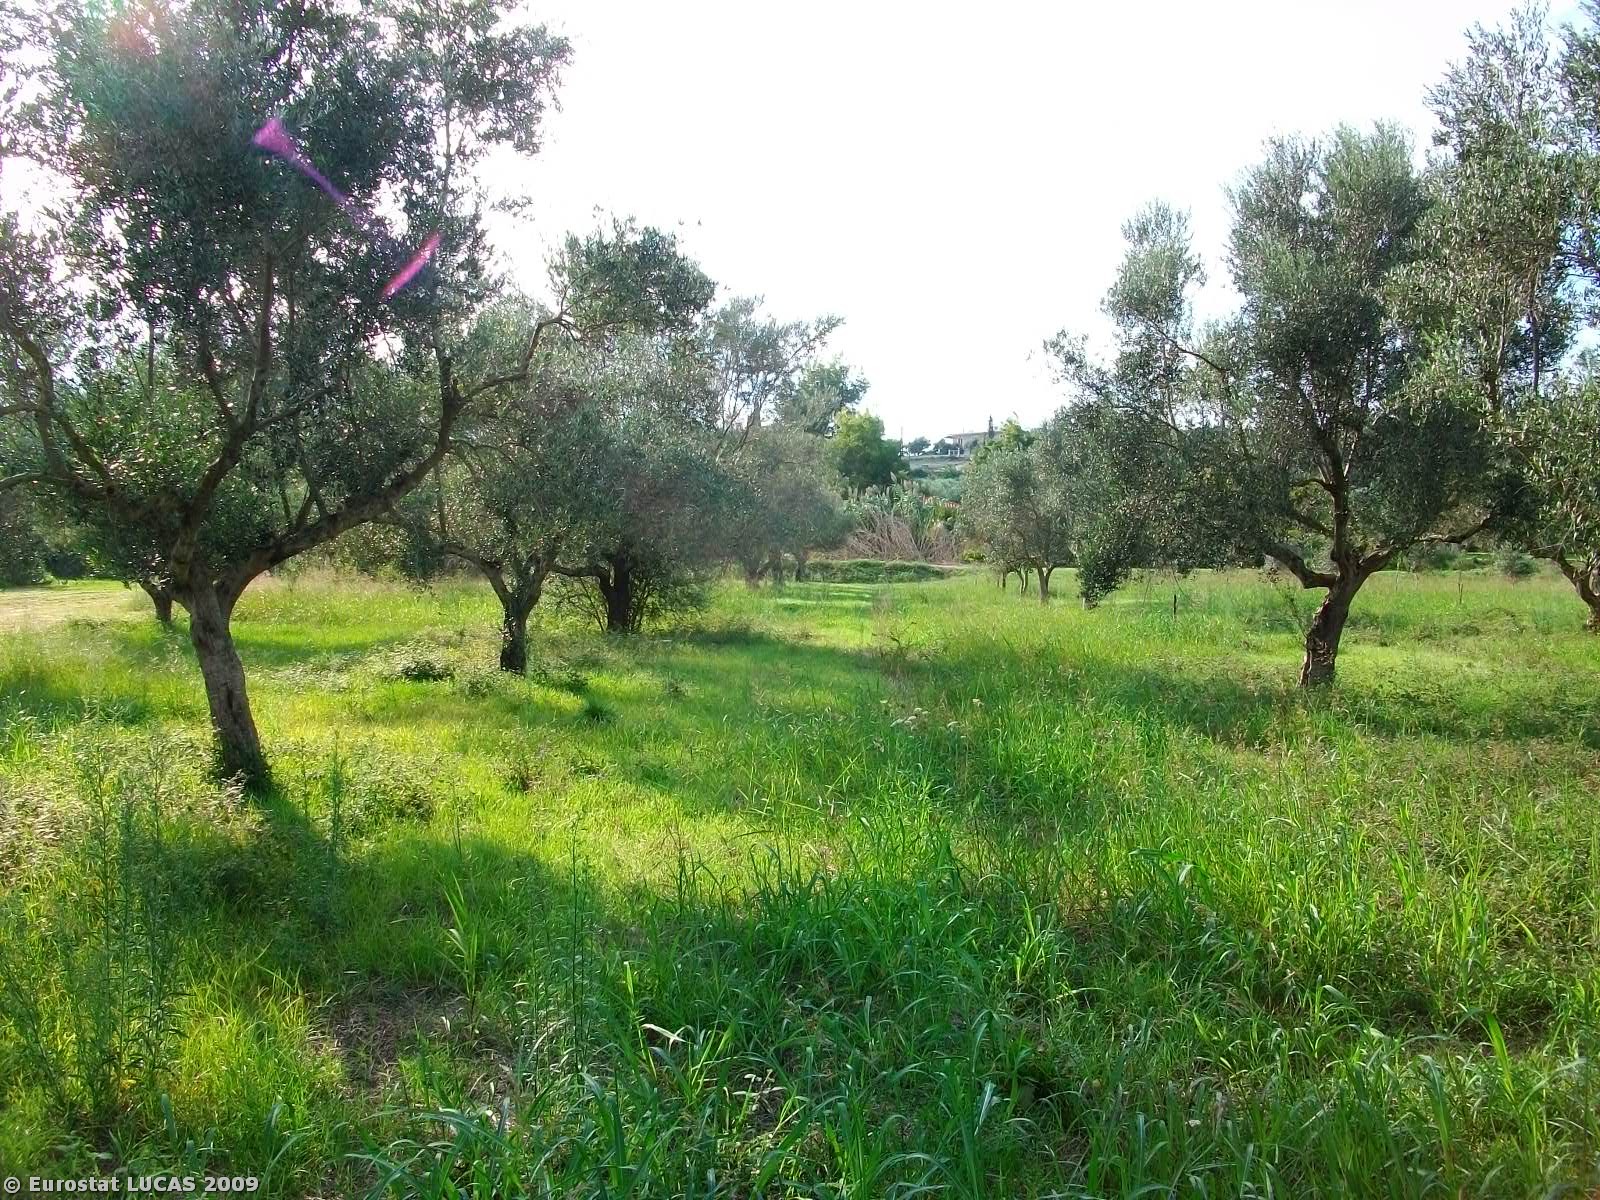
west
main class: Cropland
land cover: Olive groves
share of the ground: 10 - 25 %
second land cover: Grassland with sparse tree/shrub cover
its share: > 75 %
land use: Agriculture (excluding fallow land and kitchen gardens)
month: September
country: GR
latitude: 37.6898
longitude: 21.3327
